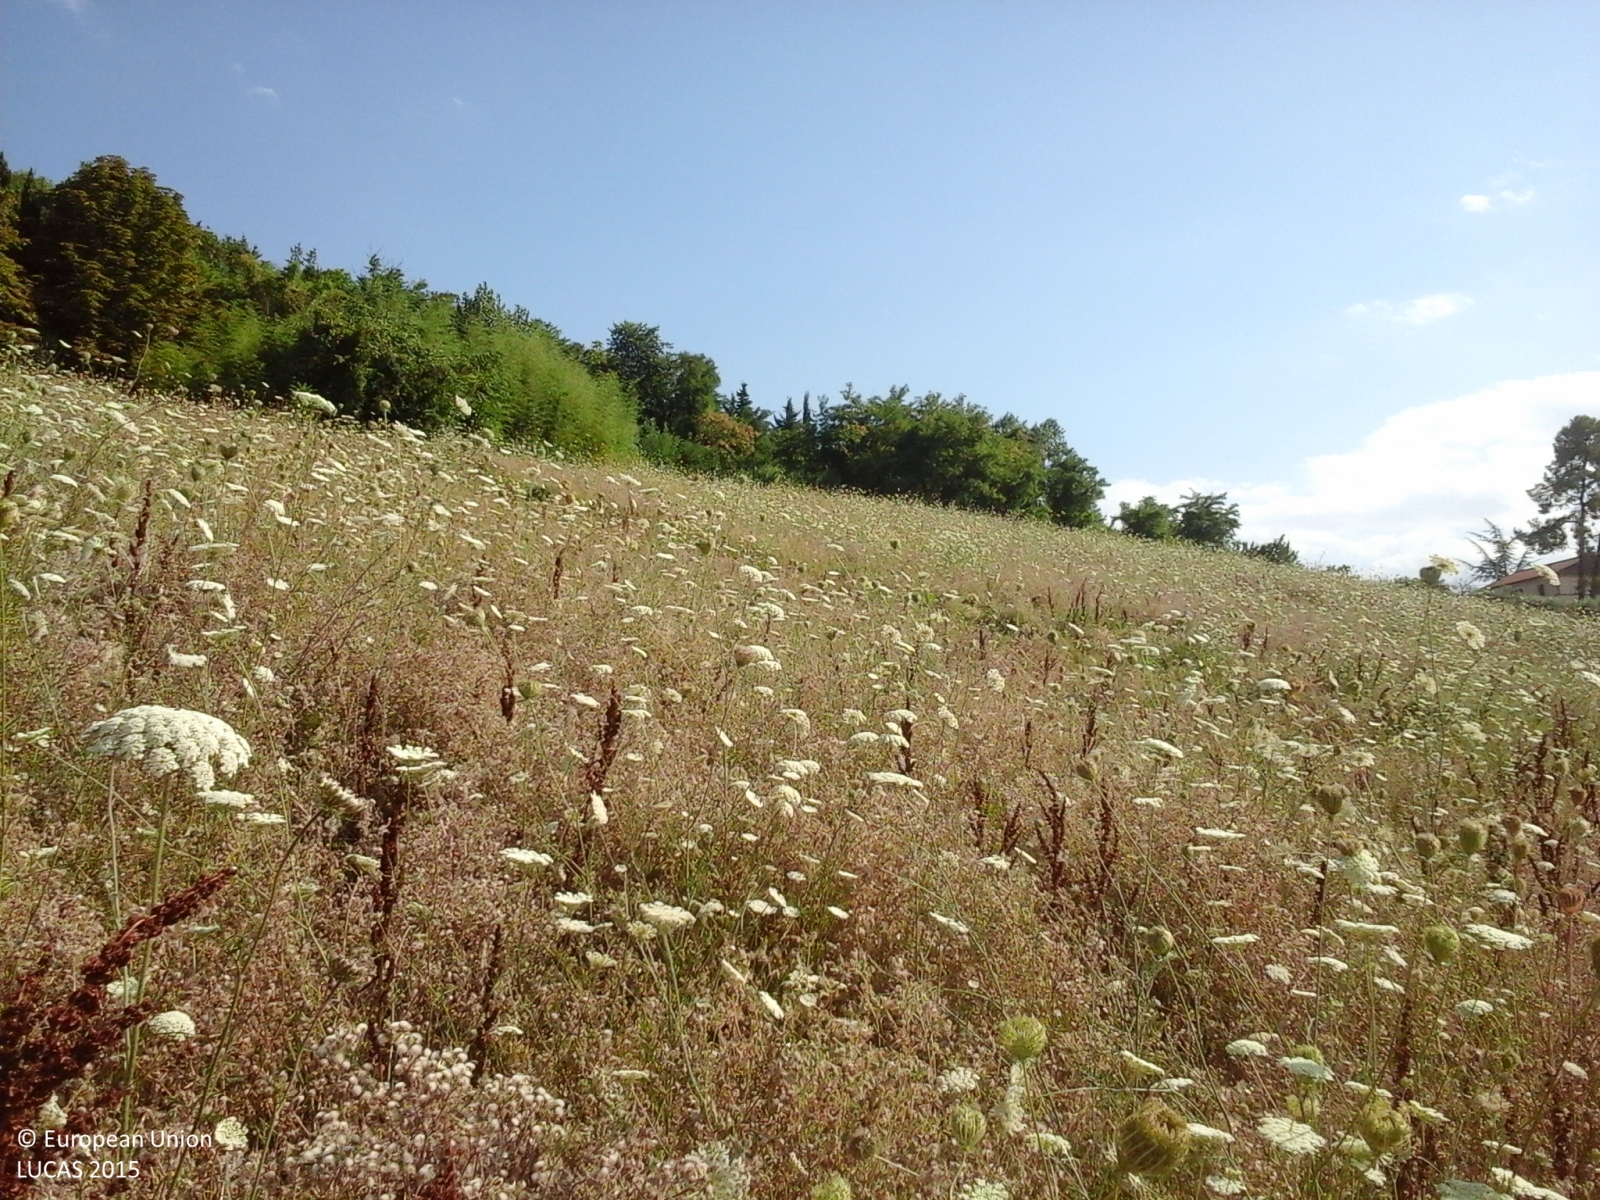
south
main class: Grassland
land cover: Spontaneously vegetated surfaces
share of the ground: > 75 %
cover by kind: herbaceous plants 95 %, shrubs 5 %
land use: Agriculture (excluding fallow land and kitchen gardens)
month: July
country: IT
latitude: 43.3187
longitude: 13.4315
